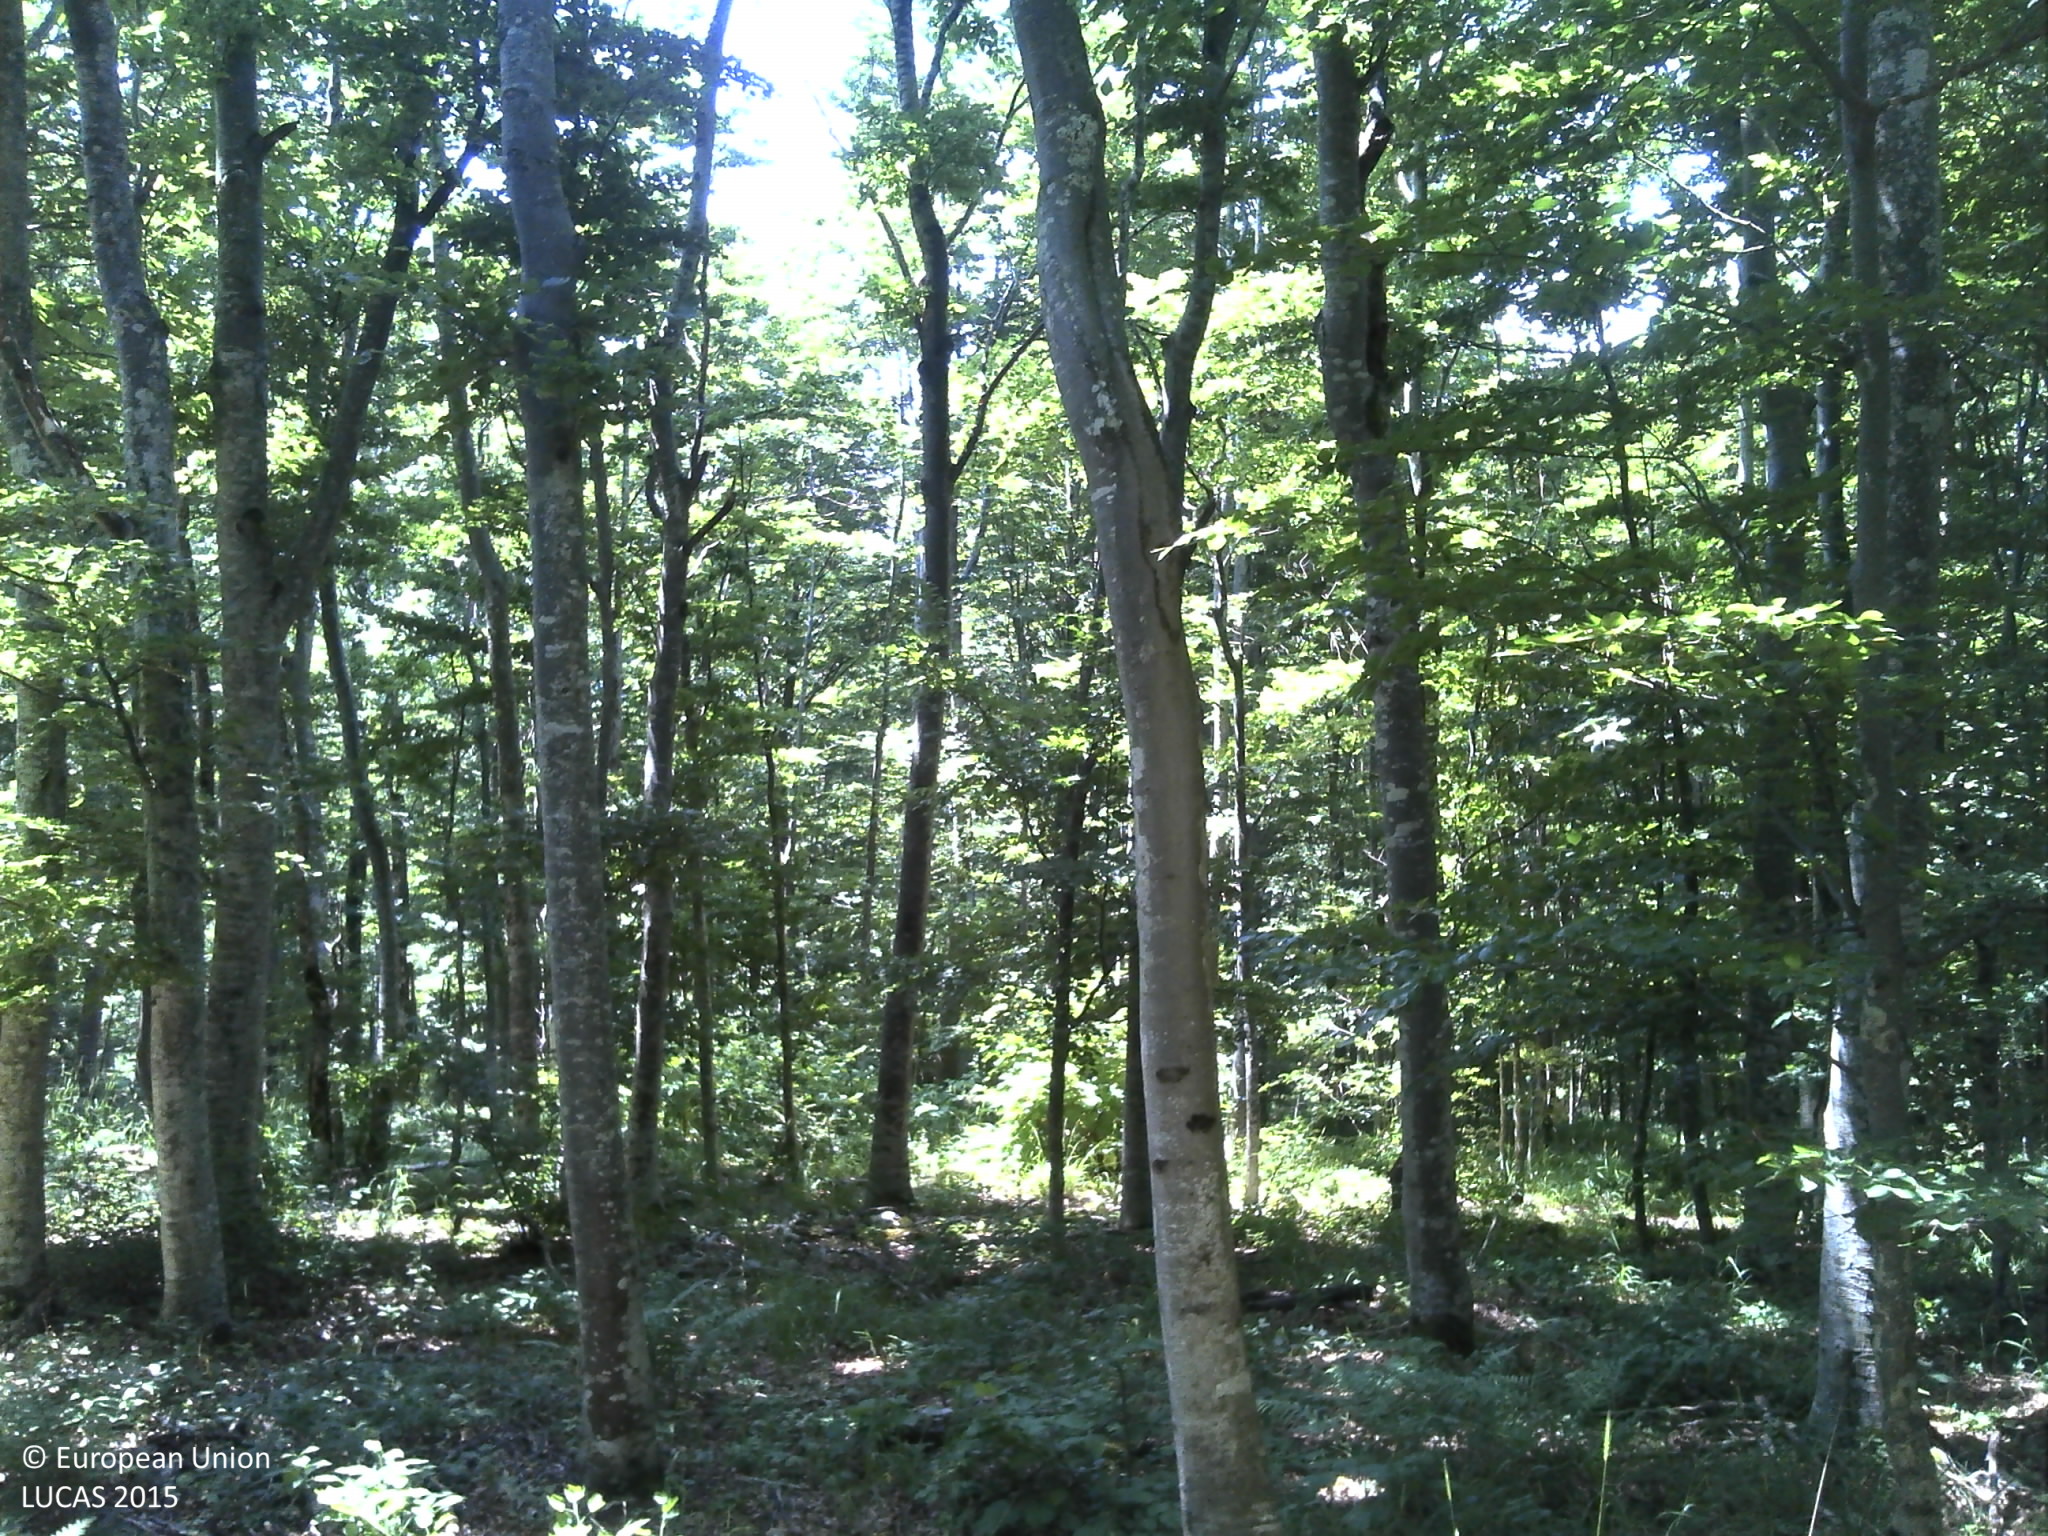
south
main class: Woodland
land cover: Broadleaved woodland
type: mountainous beech forest
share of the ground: > 75 %
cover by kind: broadleaved forest trees 95 %, consolidated bare surface 5 %
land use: Forestry
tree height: > 5 m
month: June
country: HR
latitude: 44.5042
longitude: 15.9683
